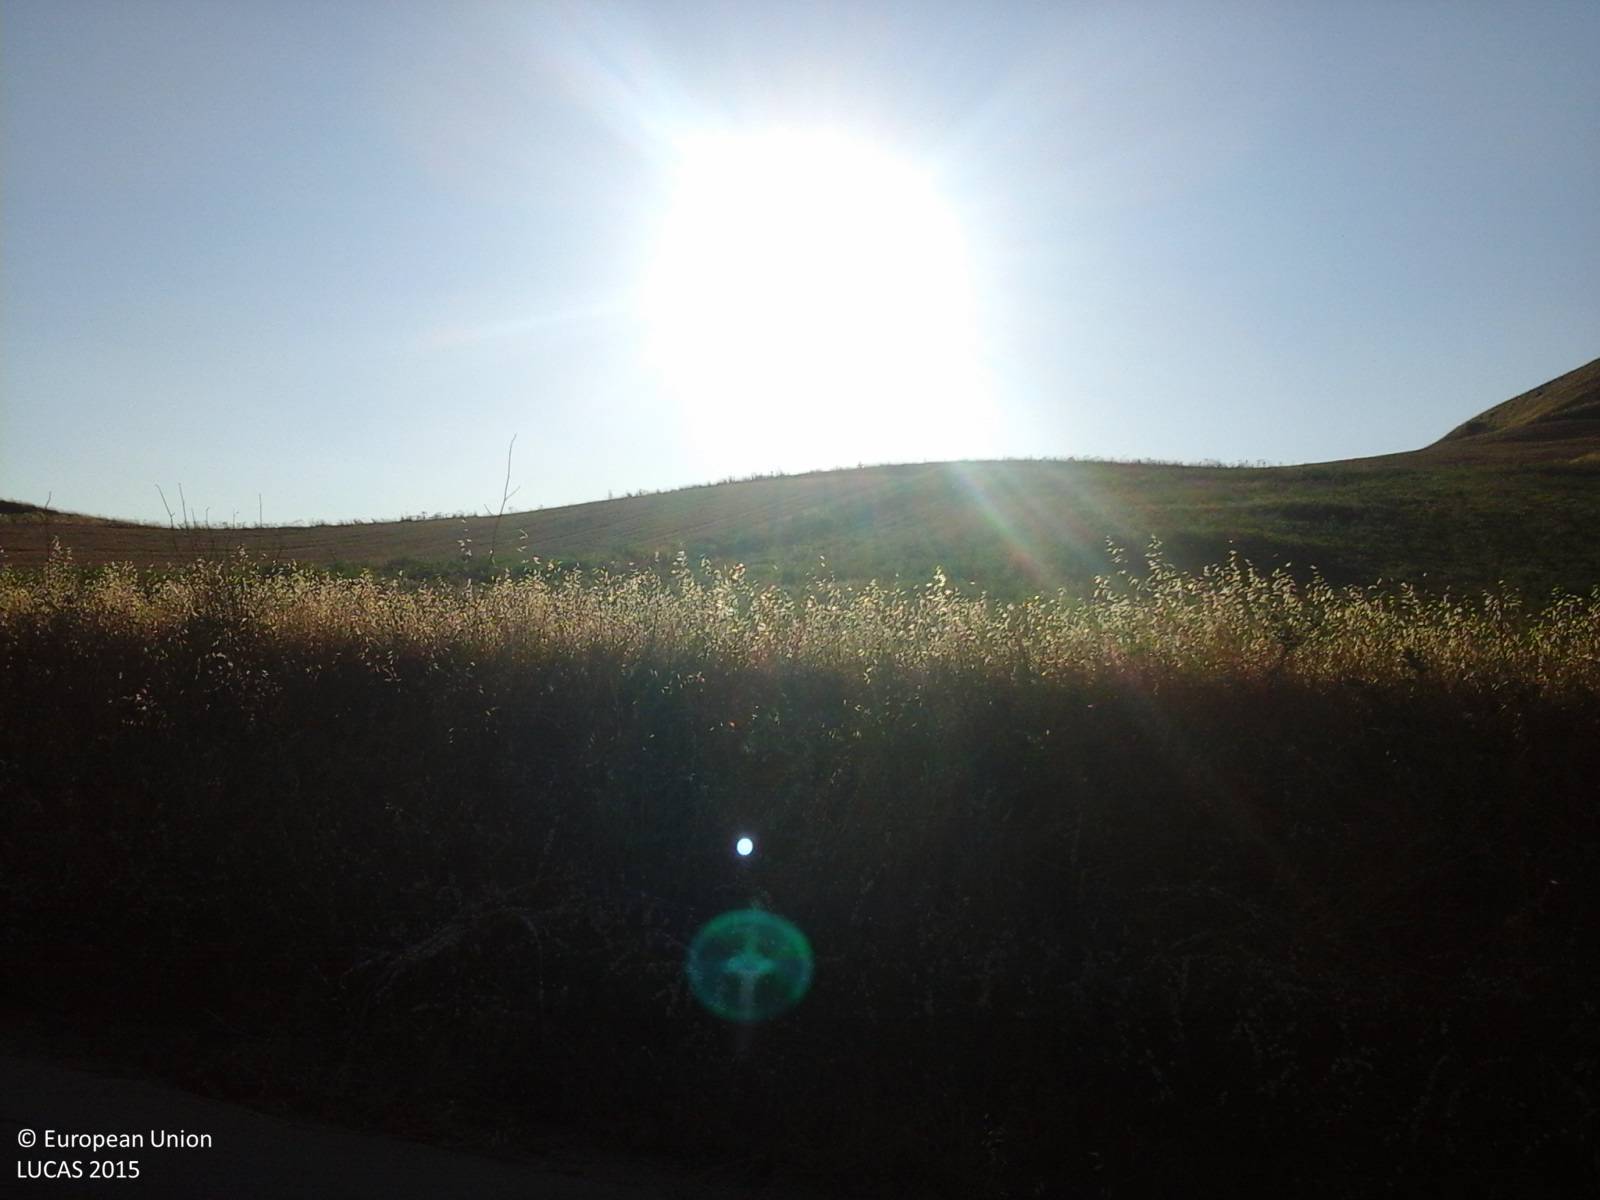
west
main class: Cropland
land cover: Durum wheat
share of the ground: > 75 %
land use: Agriculture (excluding fallow land and kitchen gardens)
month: July
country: IT
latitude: 37.7486
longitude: 13.1882
